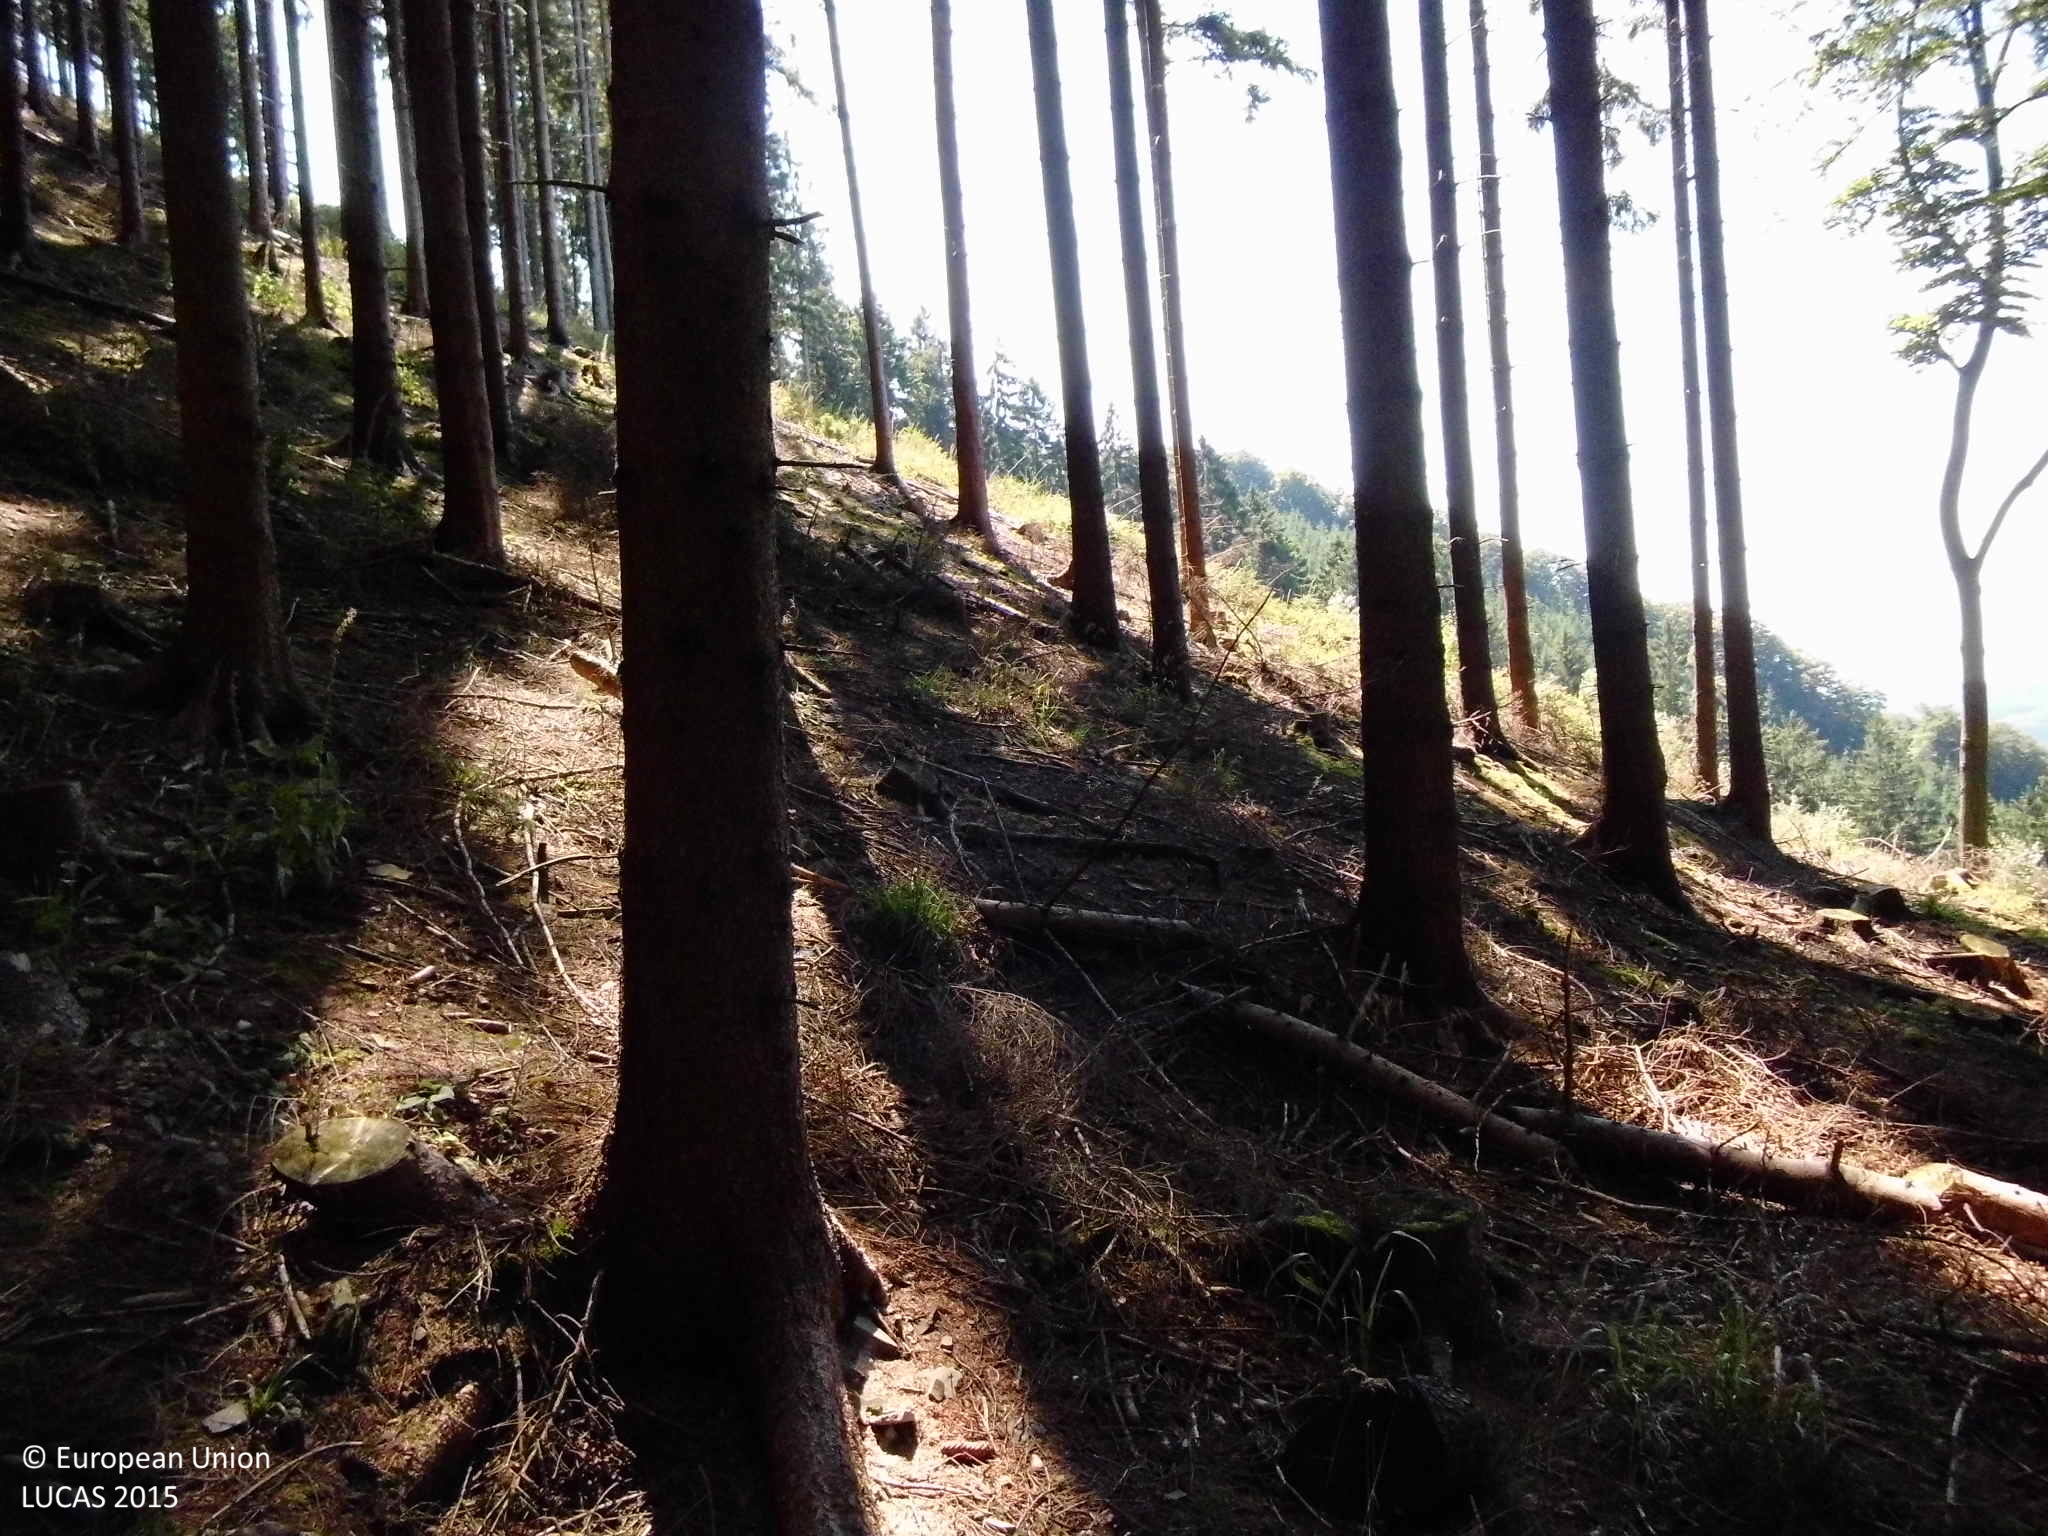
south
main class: Woodland
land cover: Spruce dominated coniferous woodland
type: hemiboreal forest and nemoral coniferous forest and mixed broadleaved-coniferous forest
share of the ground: > 75 %
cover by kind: coniferous forest trees 95 %, herbaceous plants 5 %
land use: Forestry
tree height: > 5 m
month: August
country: DE
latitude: 51.2095
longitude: 7.9820
